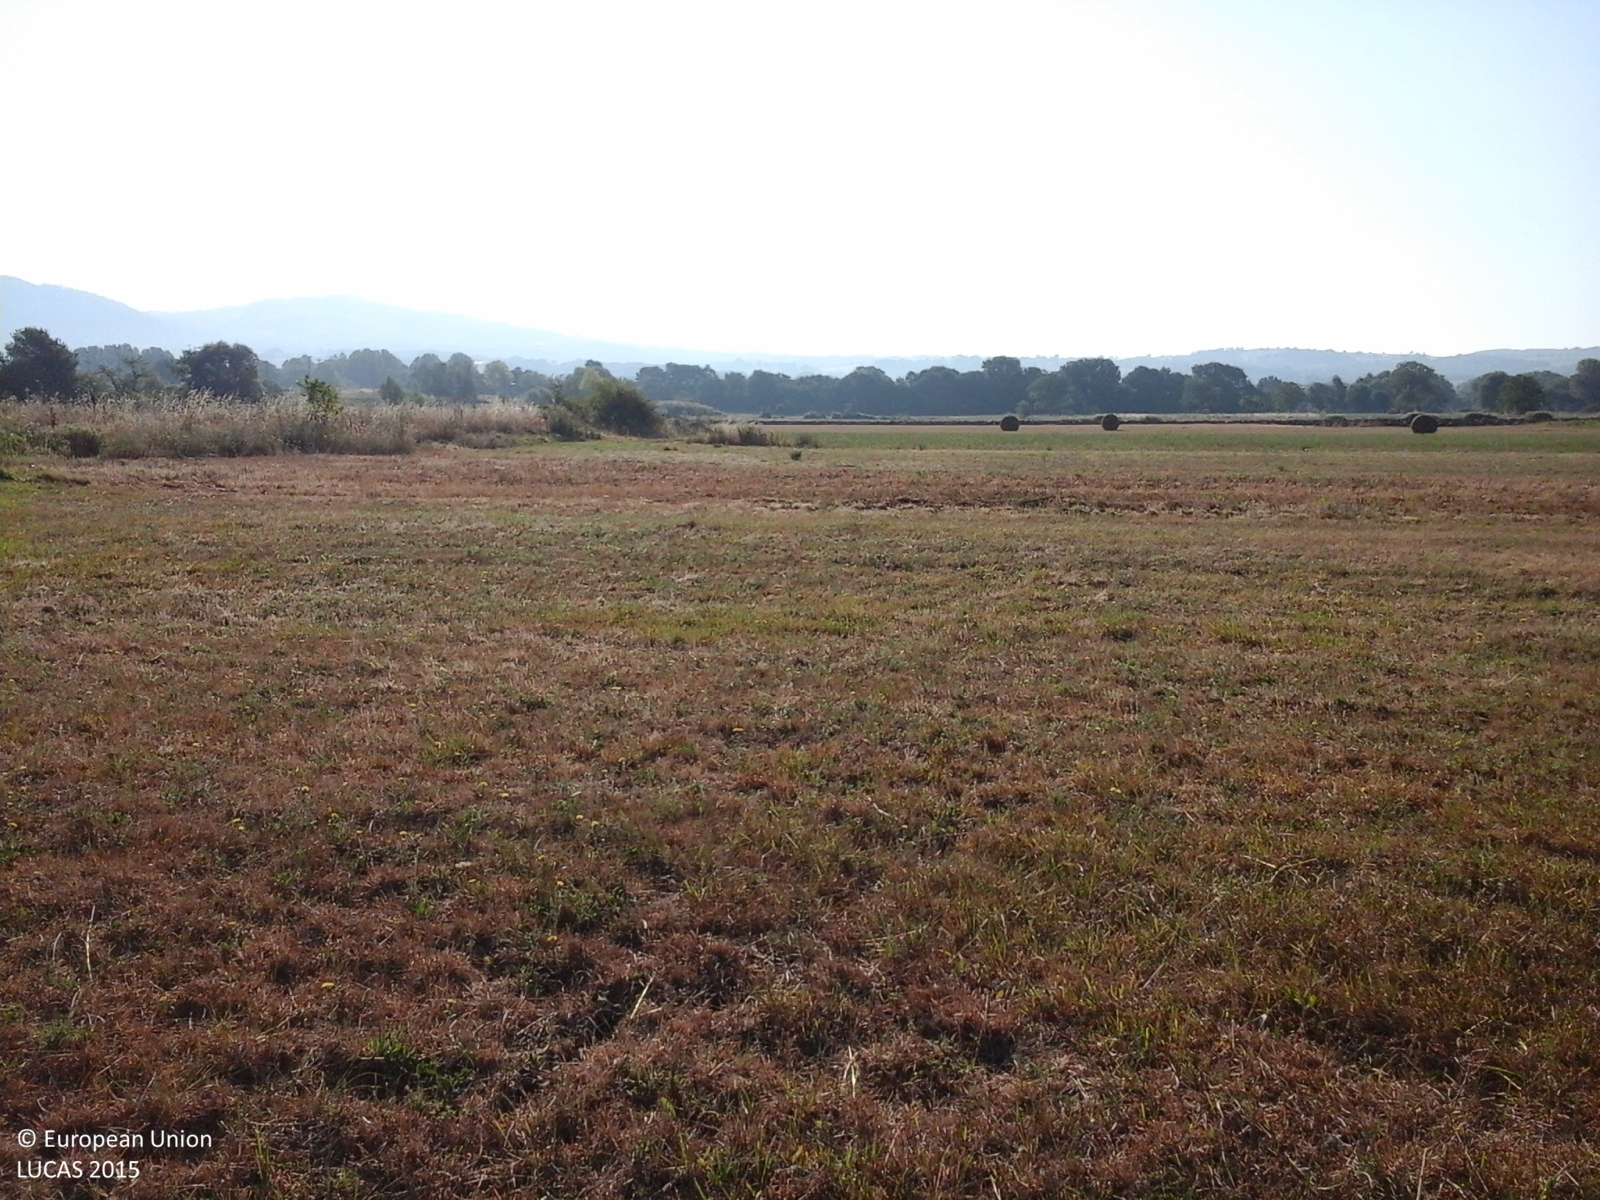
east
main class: Cropland
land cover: Temporary grasslands
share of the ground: > 75 %
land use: Agriculture (excluding fallow land and kitchen gardens)
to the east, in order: Temporary grasslands; Lucerne; Common wheat; Temporary grasslands
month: July
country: IT
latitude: 41.4427
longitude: 14.6632
